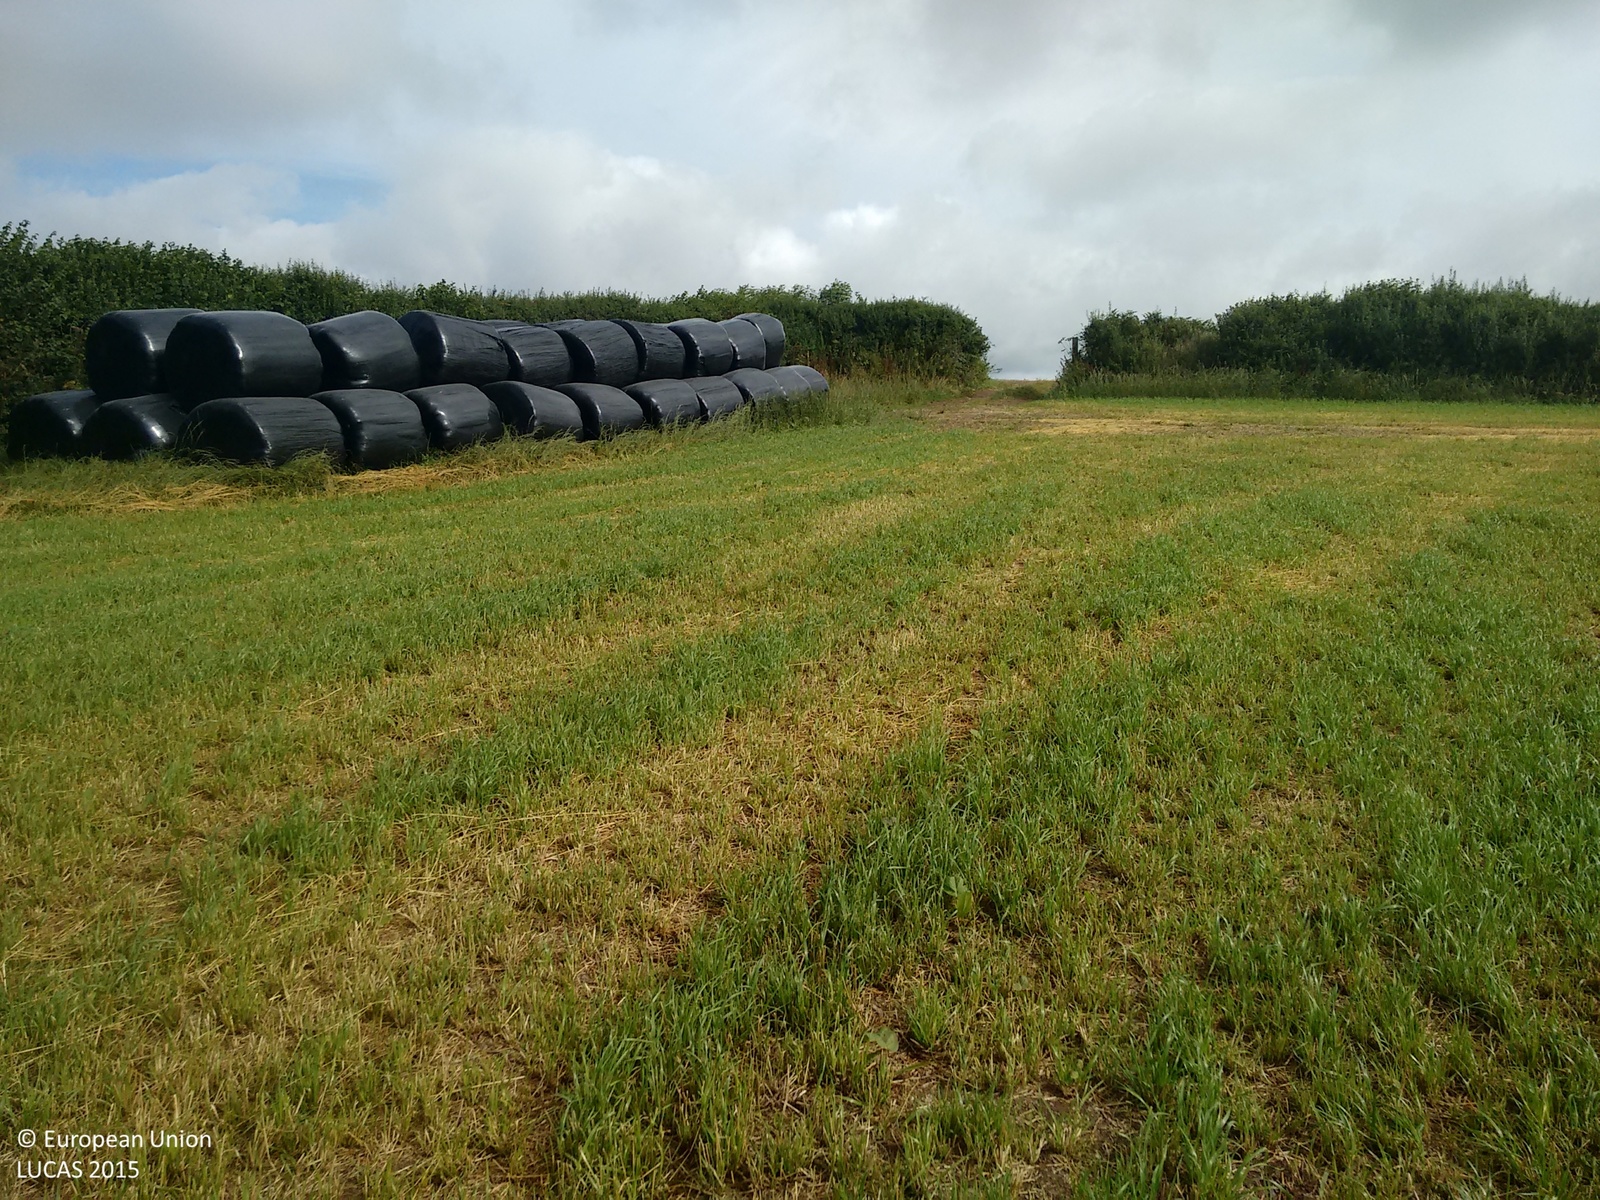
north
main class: Cropland
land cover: Temporary grasslands
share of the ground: > 75 %
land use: Agriculture (excluding fallow land and kitchen gardens)
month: August
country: GB
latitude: 50.3244
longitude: -3.9561
